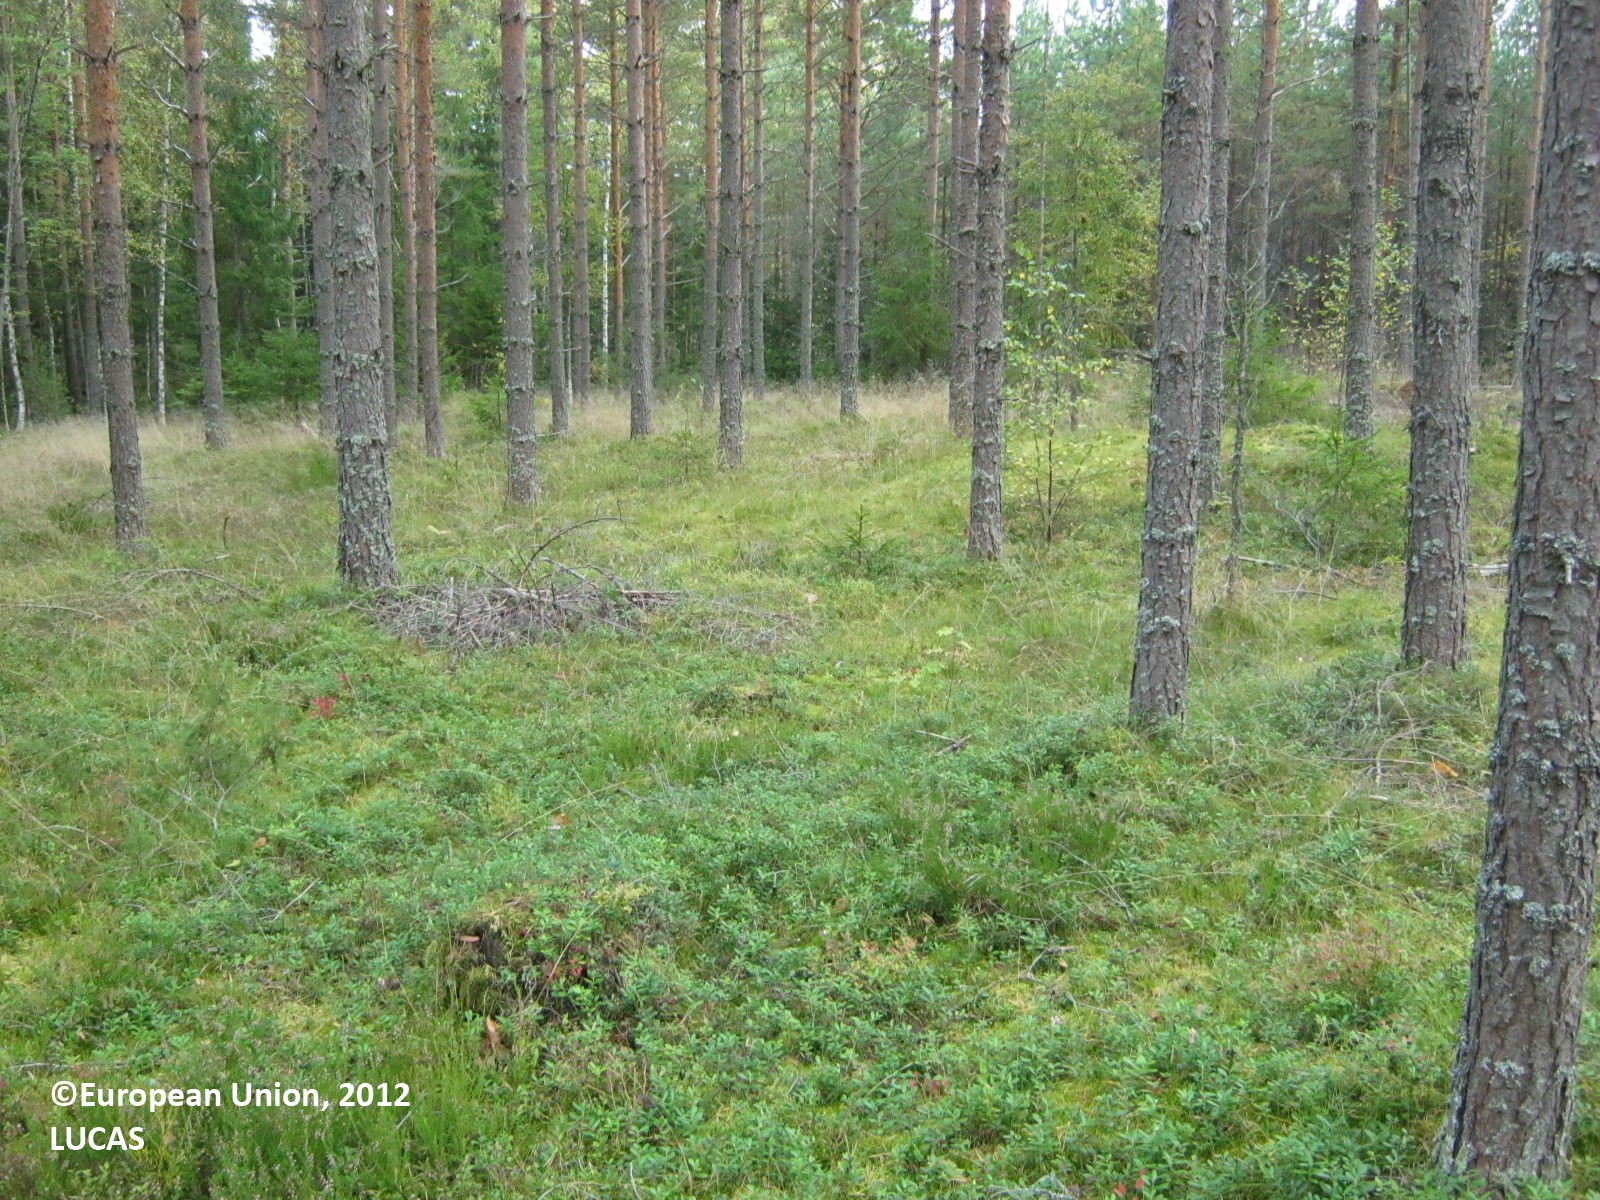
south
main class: Woodland
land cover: Pine dominated coniferous woodland
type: boreal forest
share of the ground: 50 - 75 %
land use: Forestry
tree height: > 5 m
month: September
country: FI
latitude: 60.8006
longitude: 28.0452
